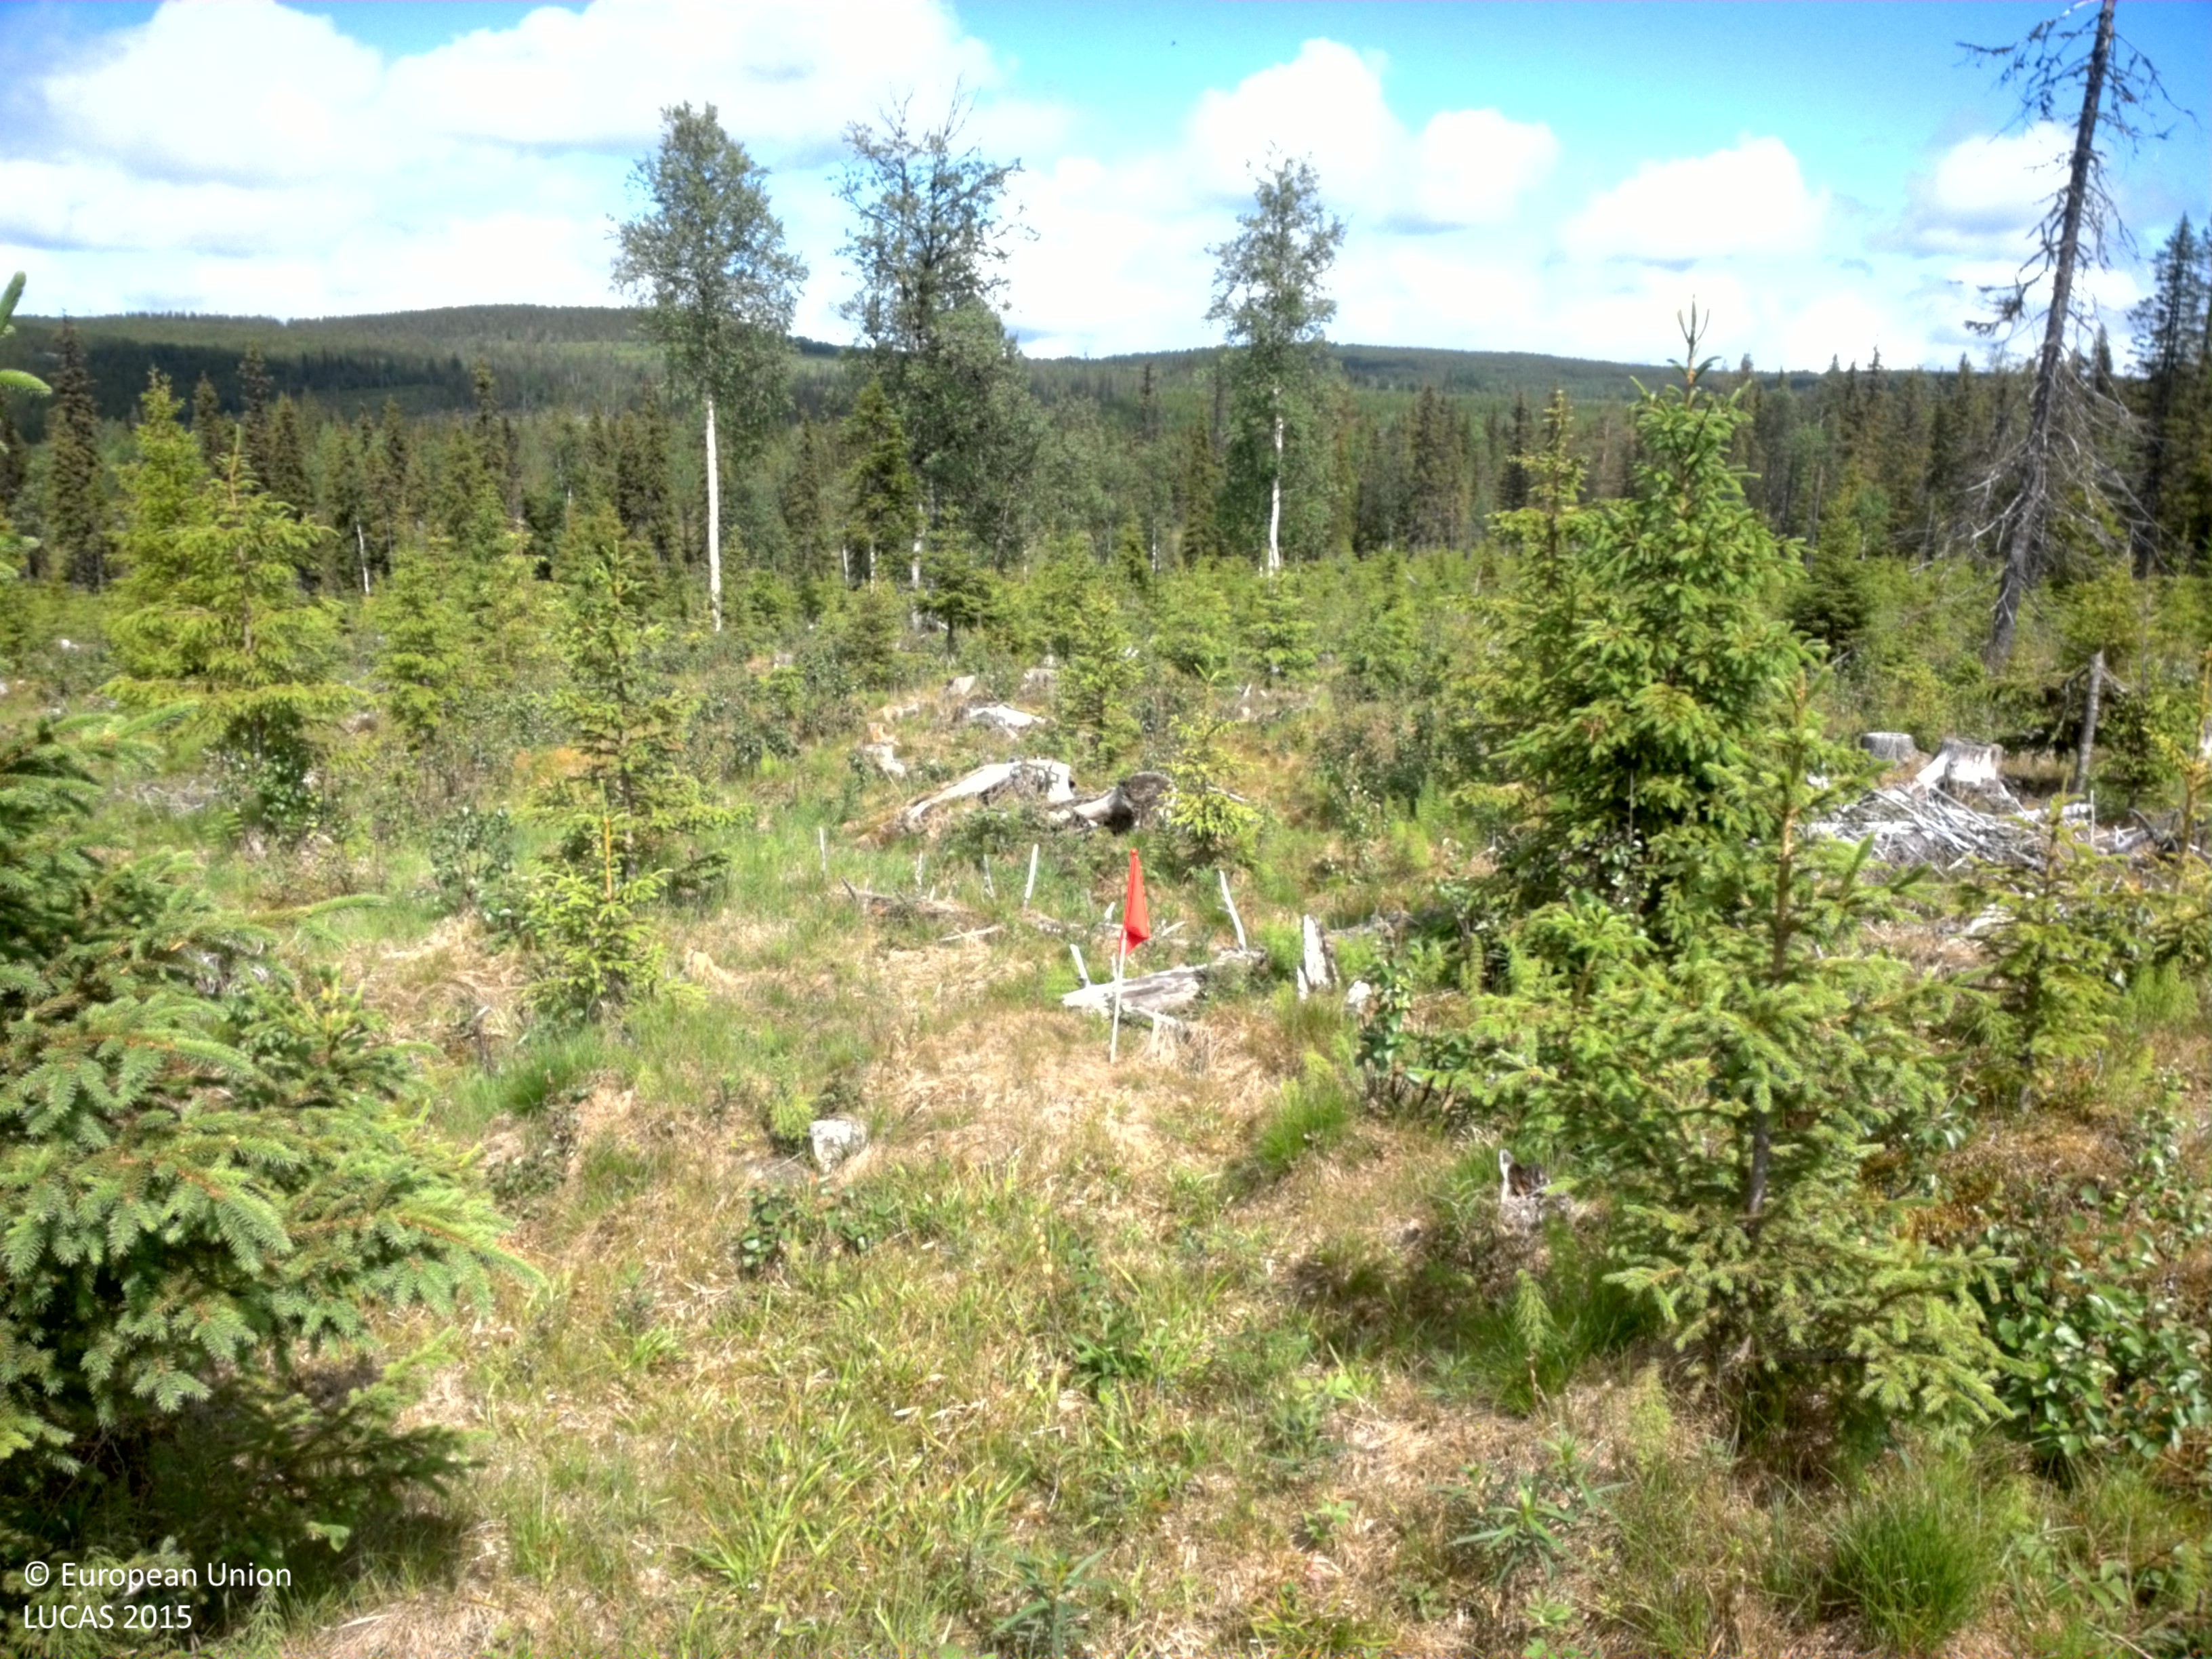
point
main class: Woodland
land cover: Spruce dominated mixed woodland
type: boreal forest
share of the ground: 50 - 75 %
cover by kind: coniferous forest trees 45 %, broadleaved forest trees 30 %, herbaceous plants 20 %, shrubs 5 %
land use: Forestry
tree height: < 5 m
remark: Clear cut
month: July
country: SE
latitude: 64.4796
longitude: 18.1435
